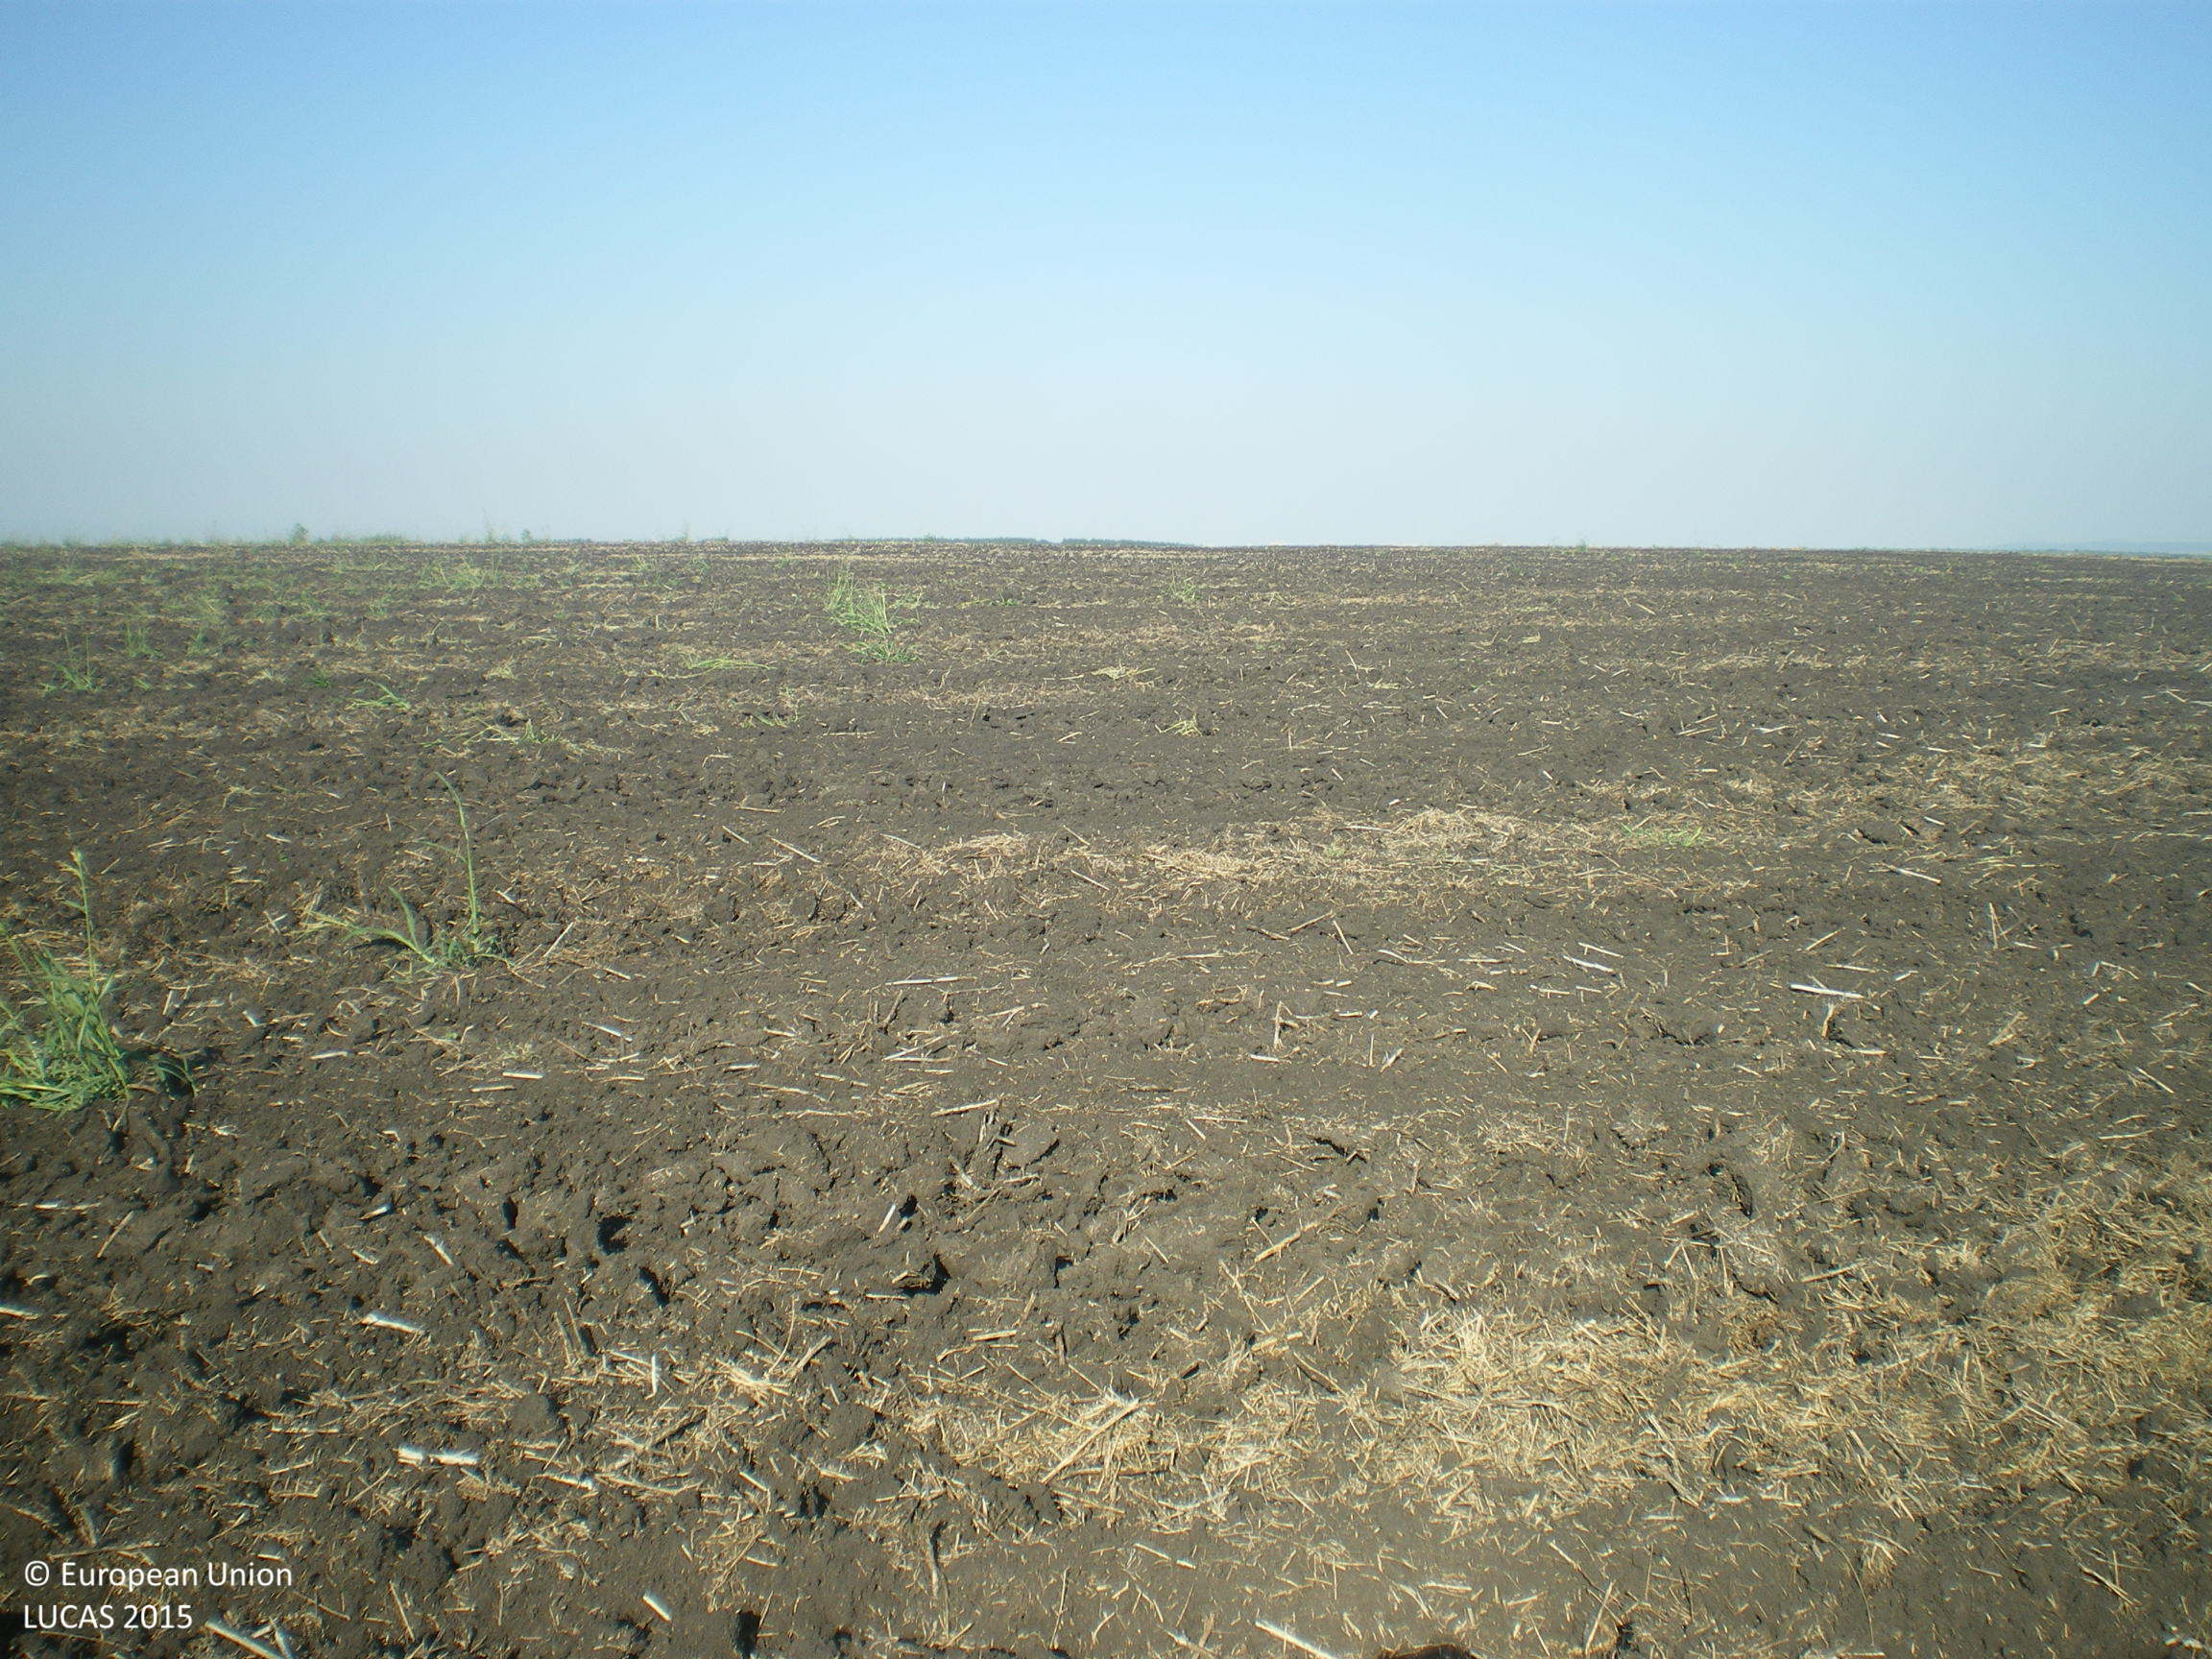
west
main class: Cropland
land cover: Rape and turnip rape
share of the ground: < 10 %
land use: Agriculture (excluding fallow land and kitchen gardens)
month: August
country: BG
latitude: 42.1776
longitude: 25.6751
